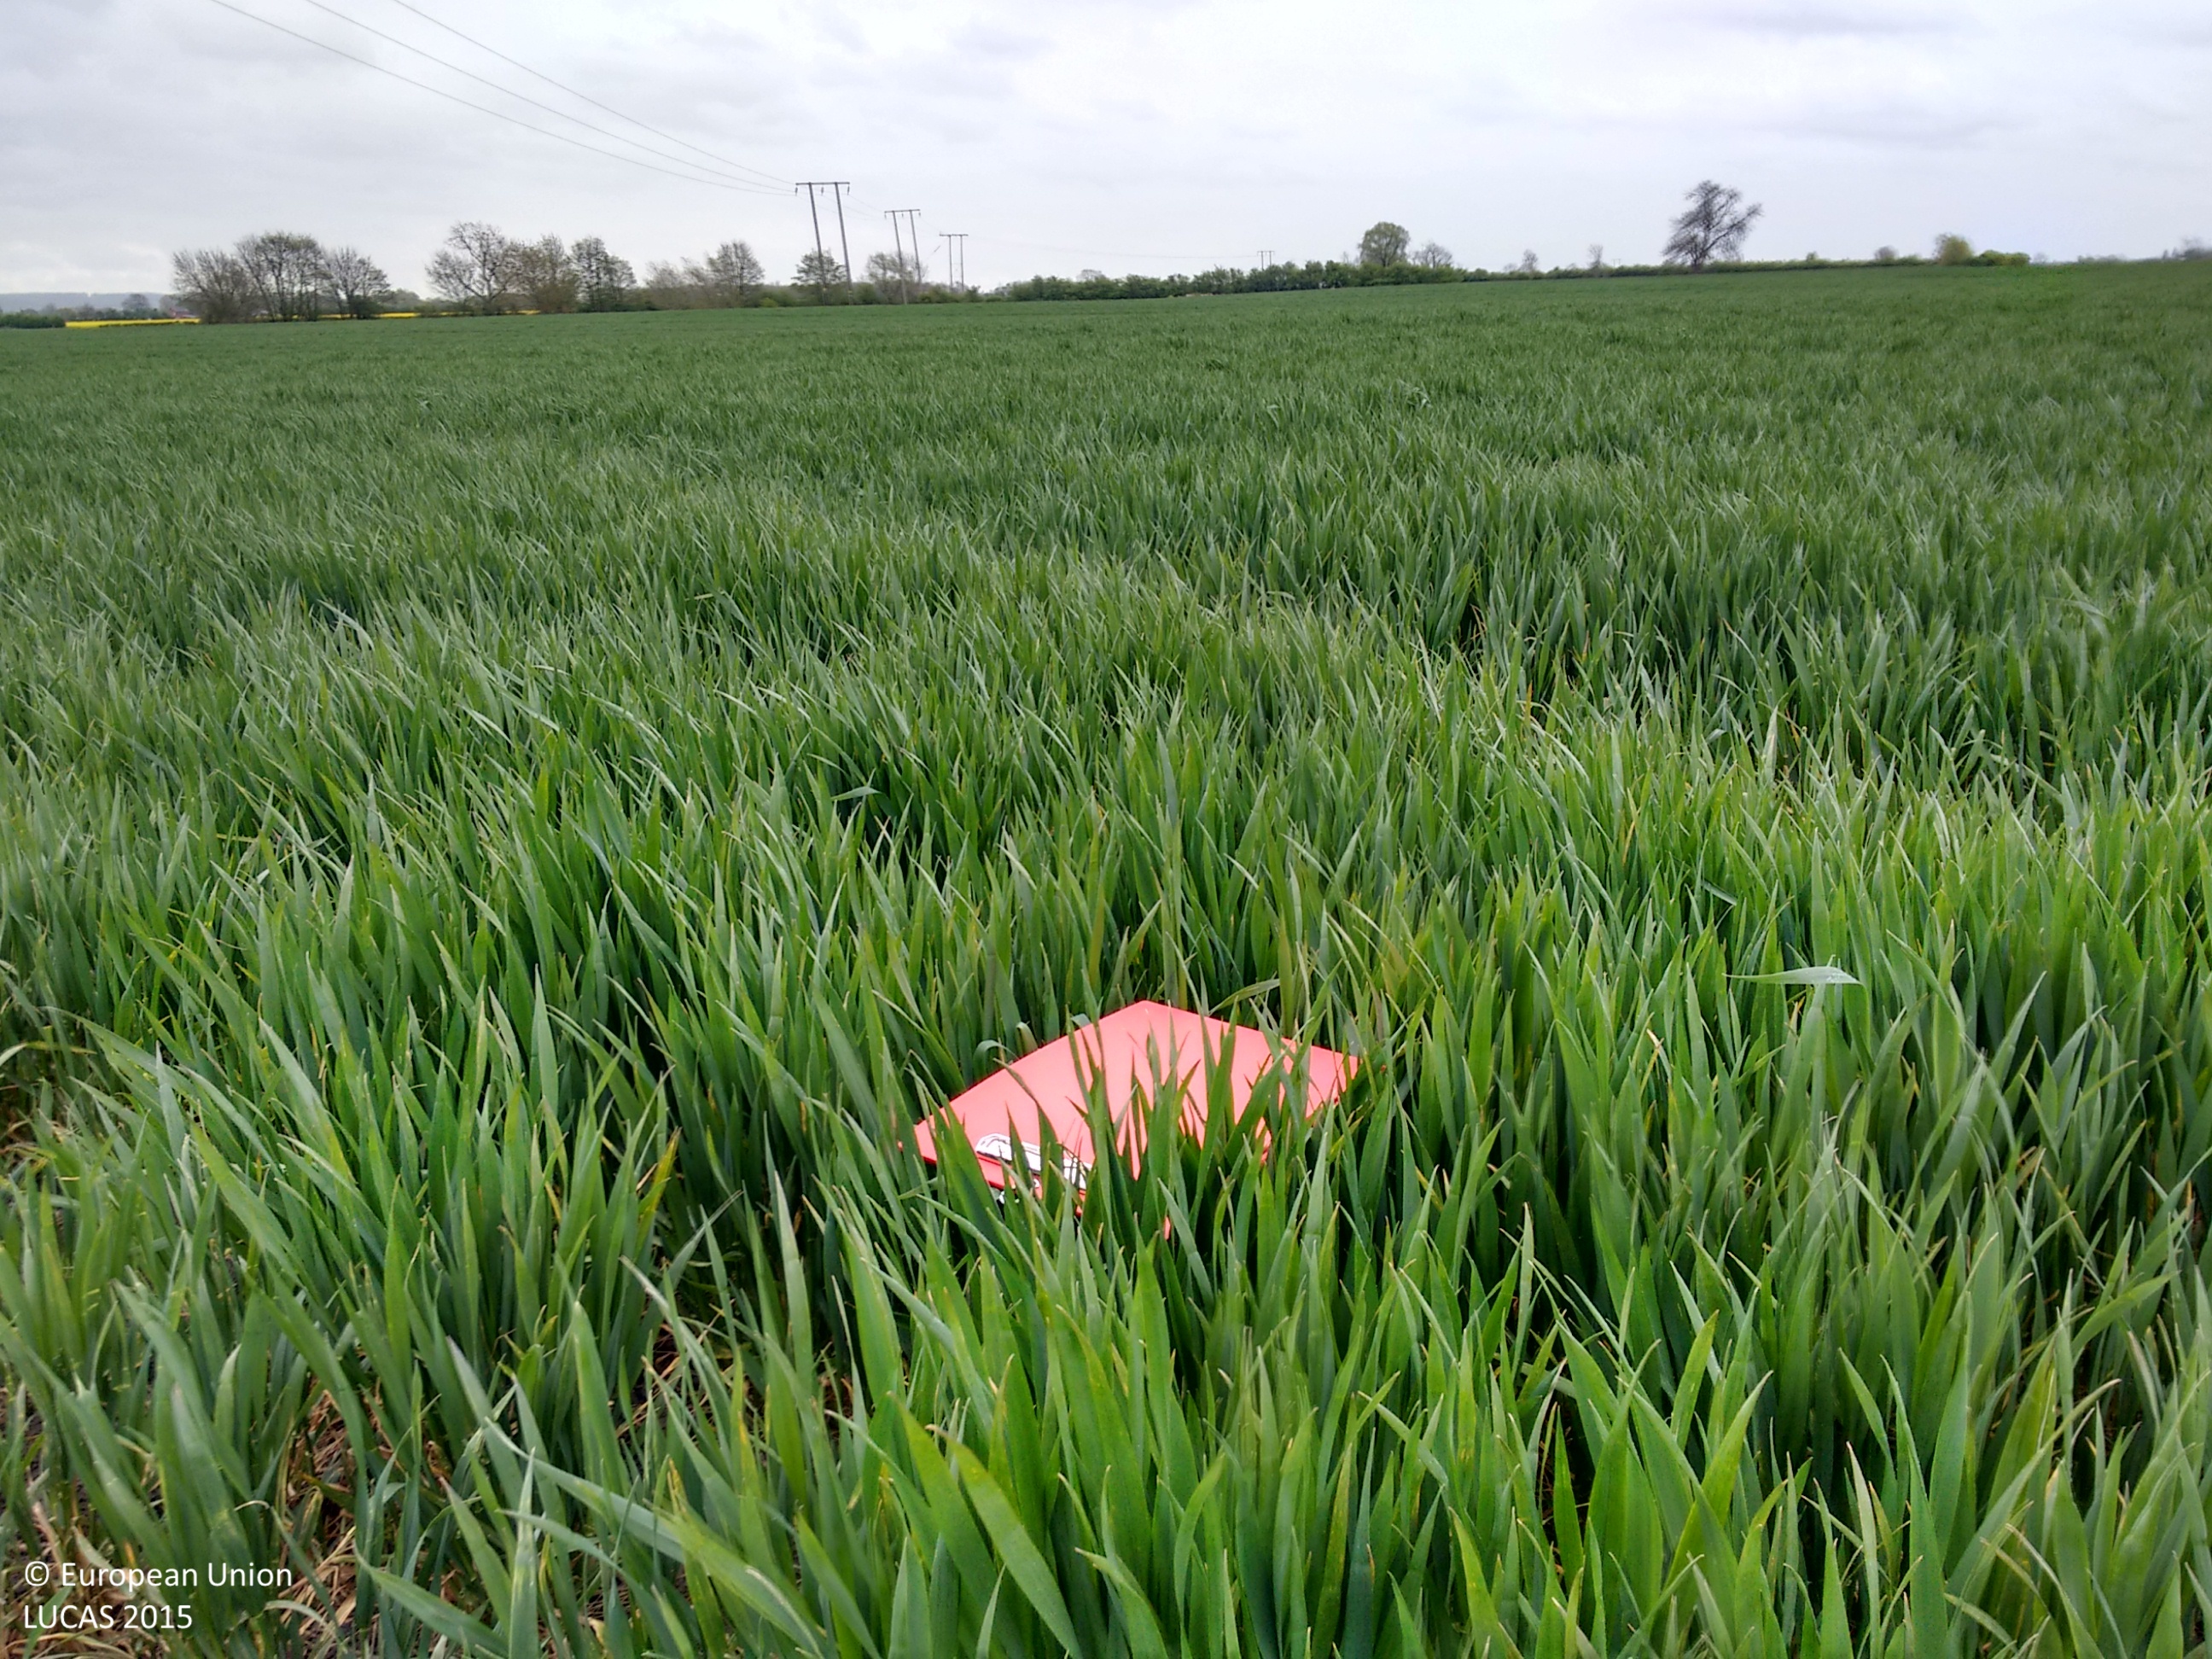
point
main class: Cropland
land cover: Barley
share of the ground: > 75 %
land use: Agriculture (excluding fallow land and kitchen gardens)
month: May
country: GB
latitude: 53.7784
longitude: -0.7075
